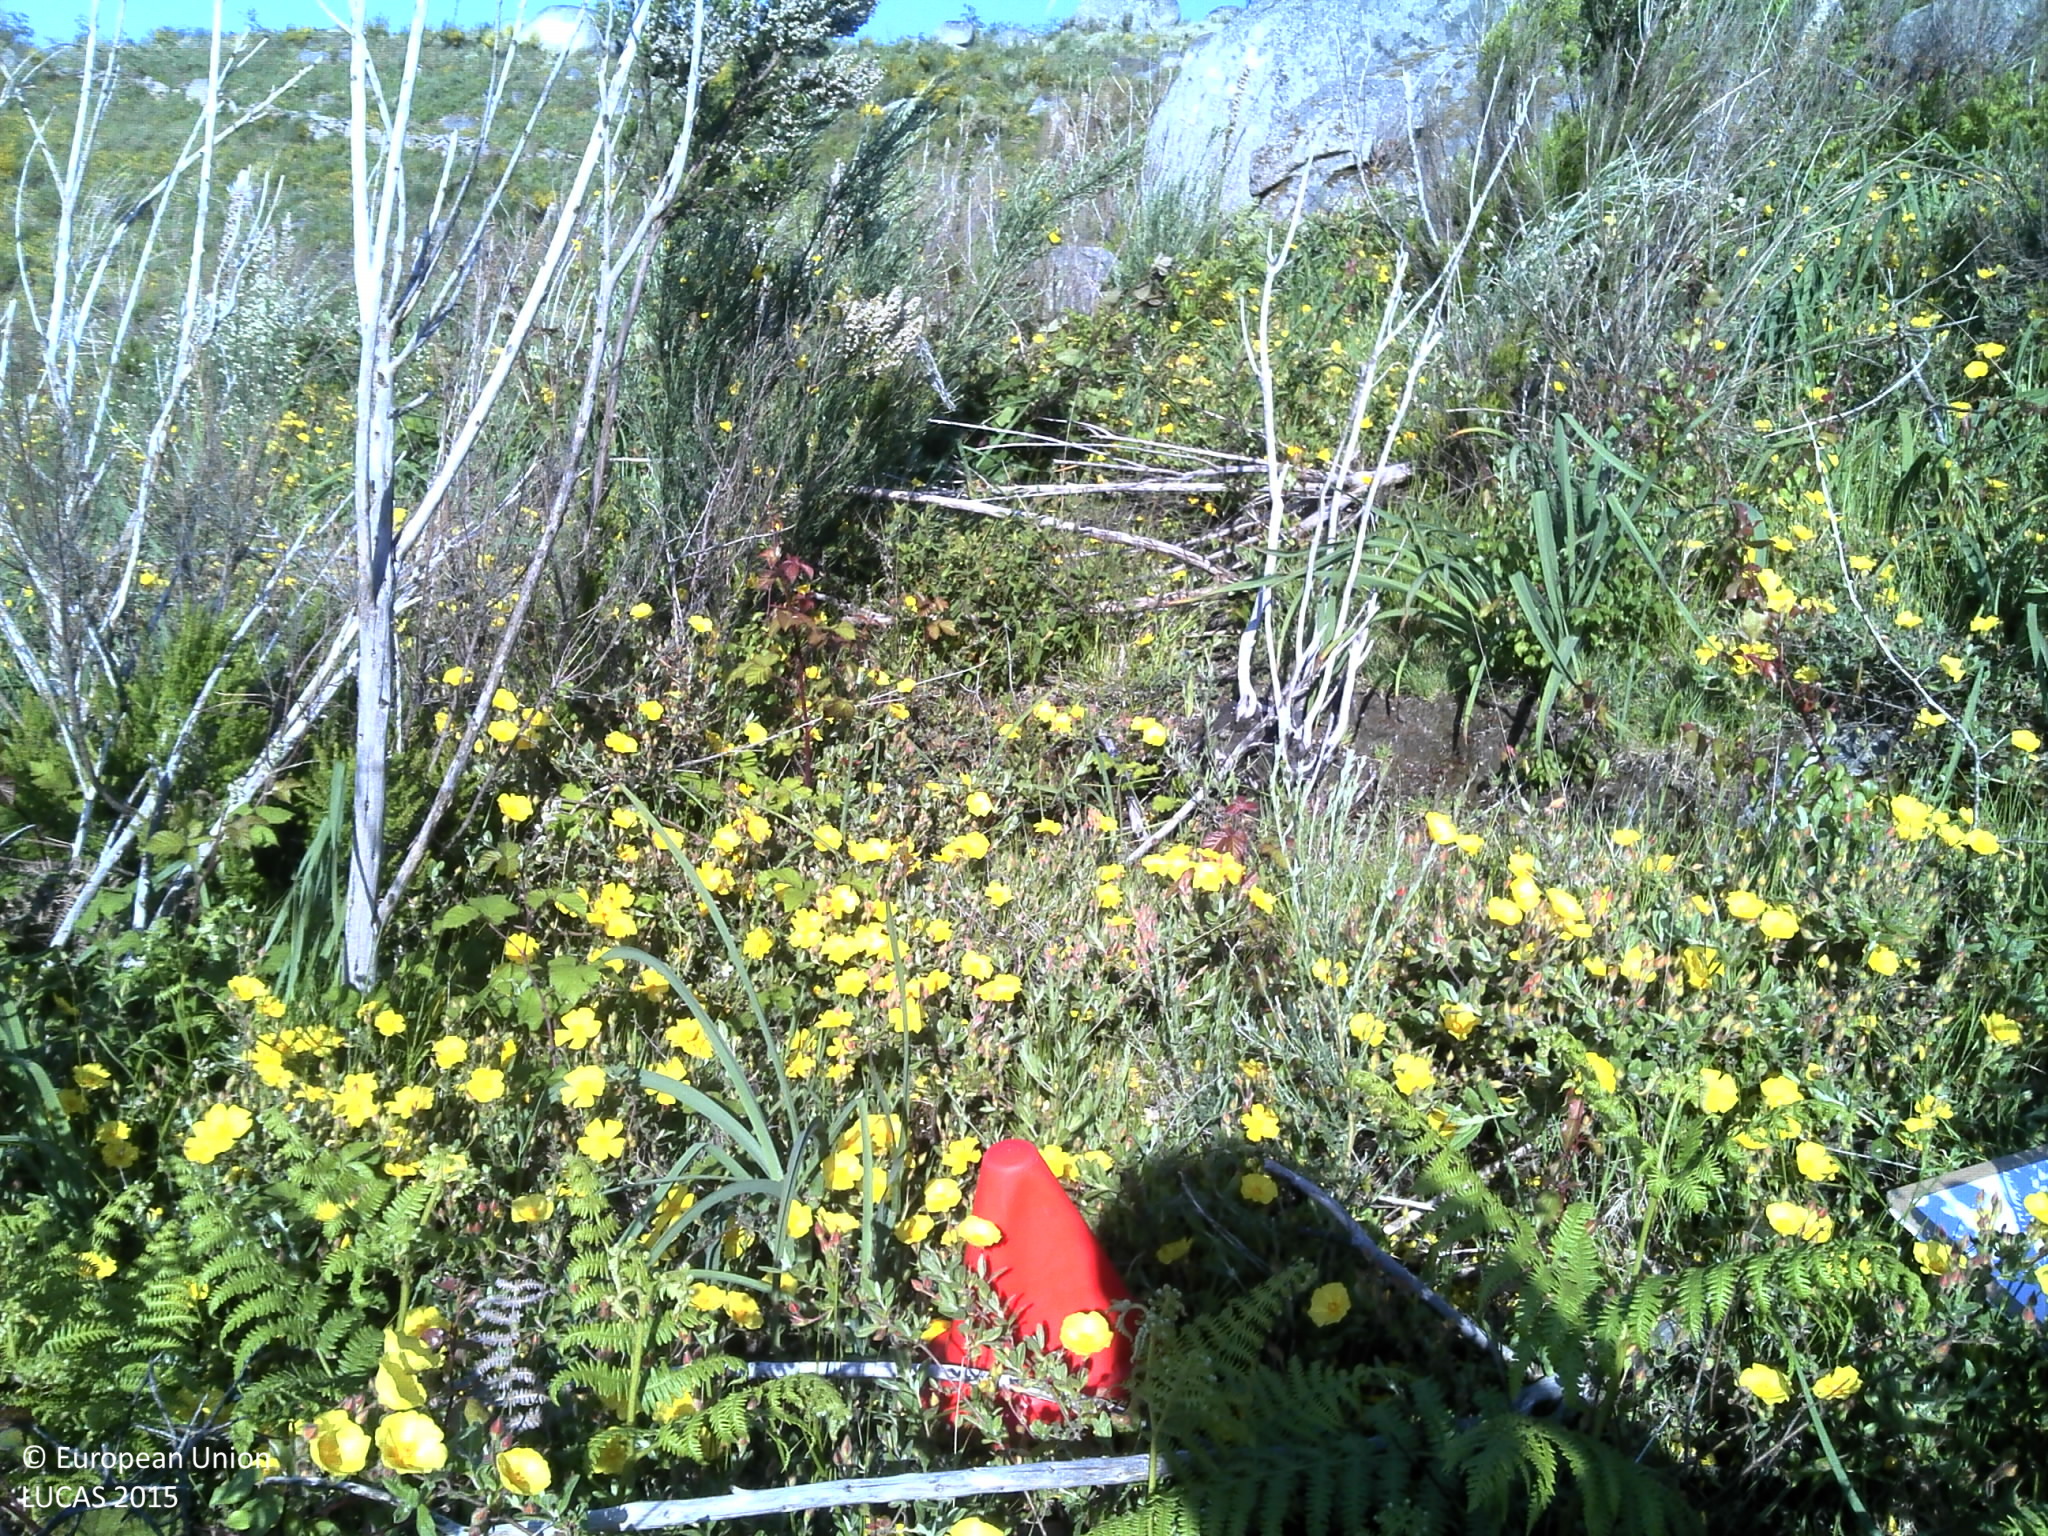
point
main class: Shrubland
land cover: Shrubland without tree cover
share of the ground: > 75 %
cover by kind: shrubs 80 %, unconsolidated bare surface 15 %, herbaceous plants 5 %
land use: Agriculture (excluding fallow land and kitchen gardens)
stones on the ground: < 10 %
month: May
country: PT
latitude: 41.0334
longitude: -8.1576
